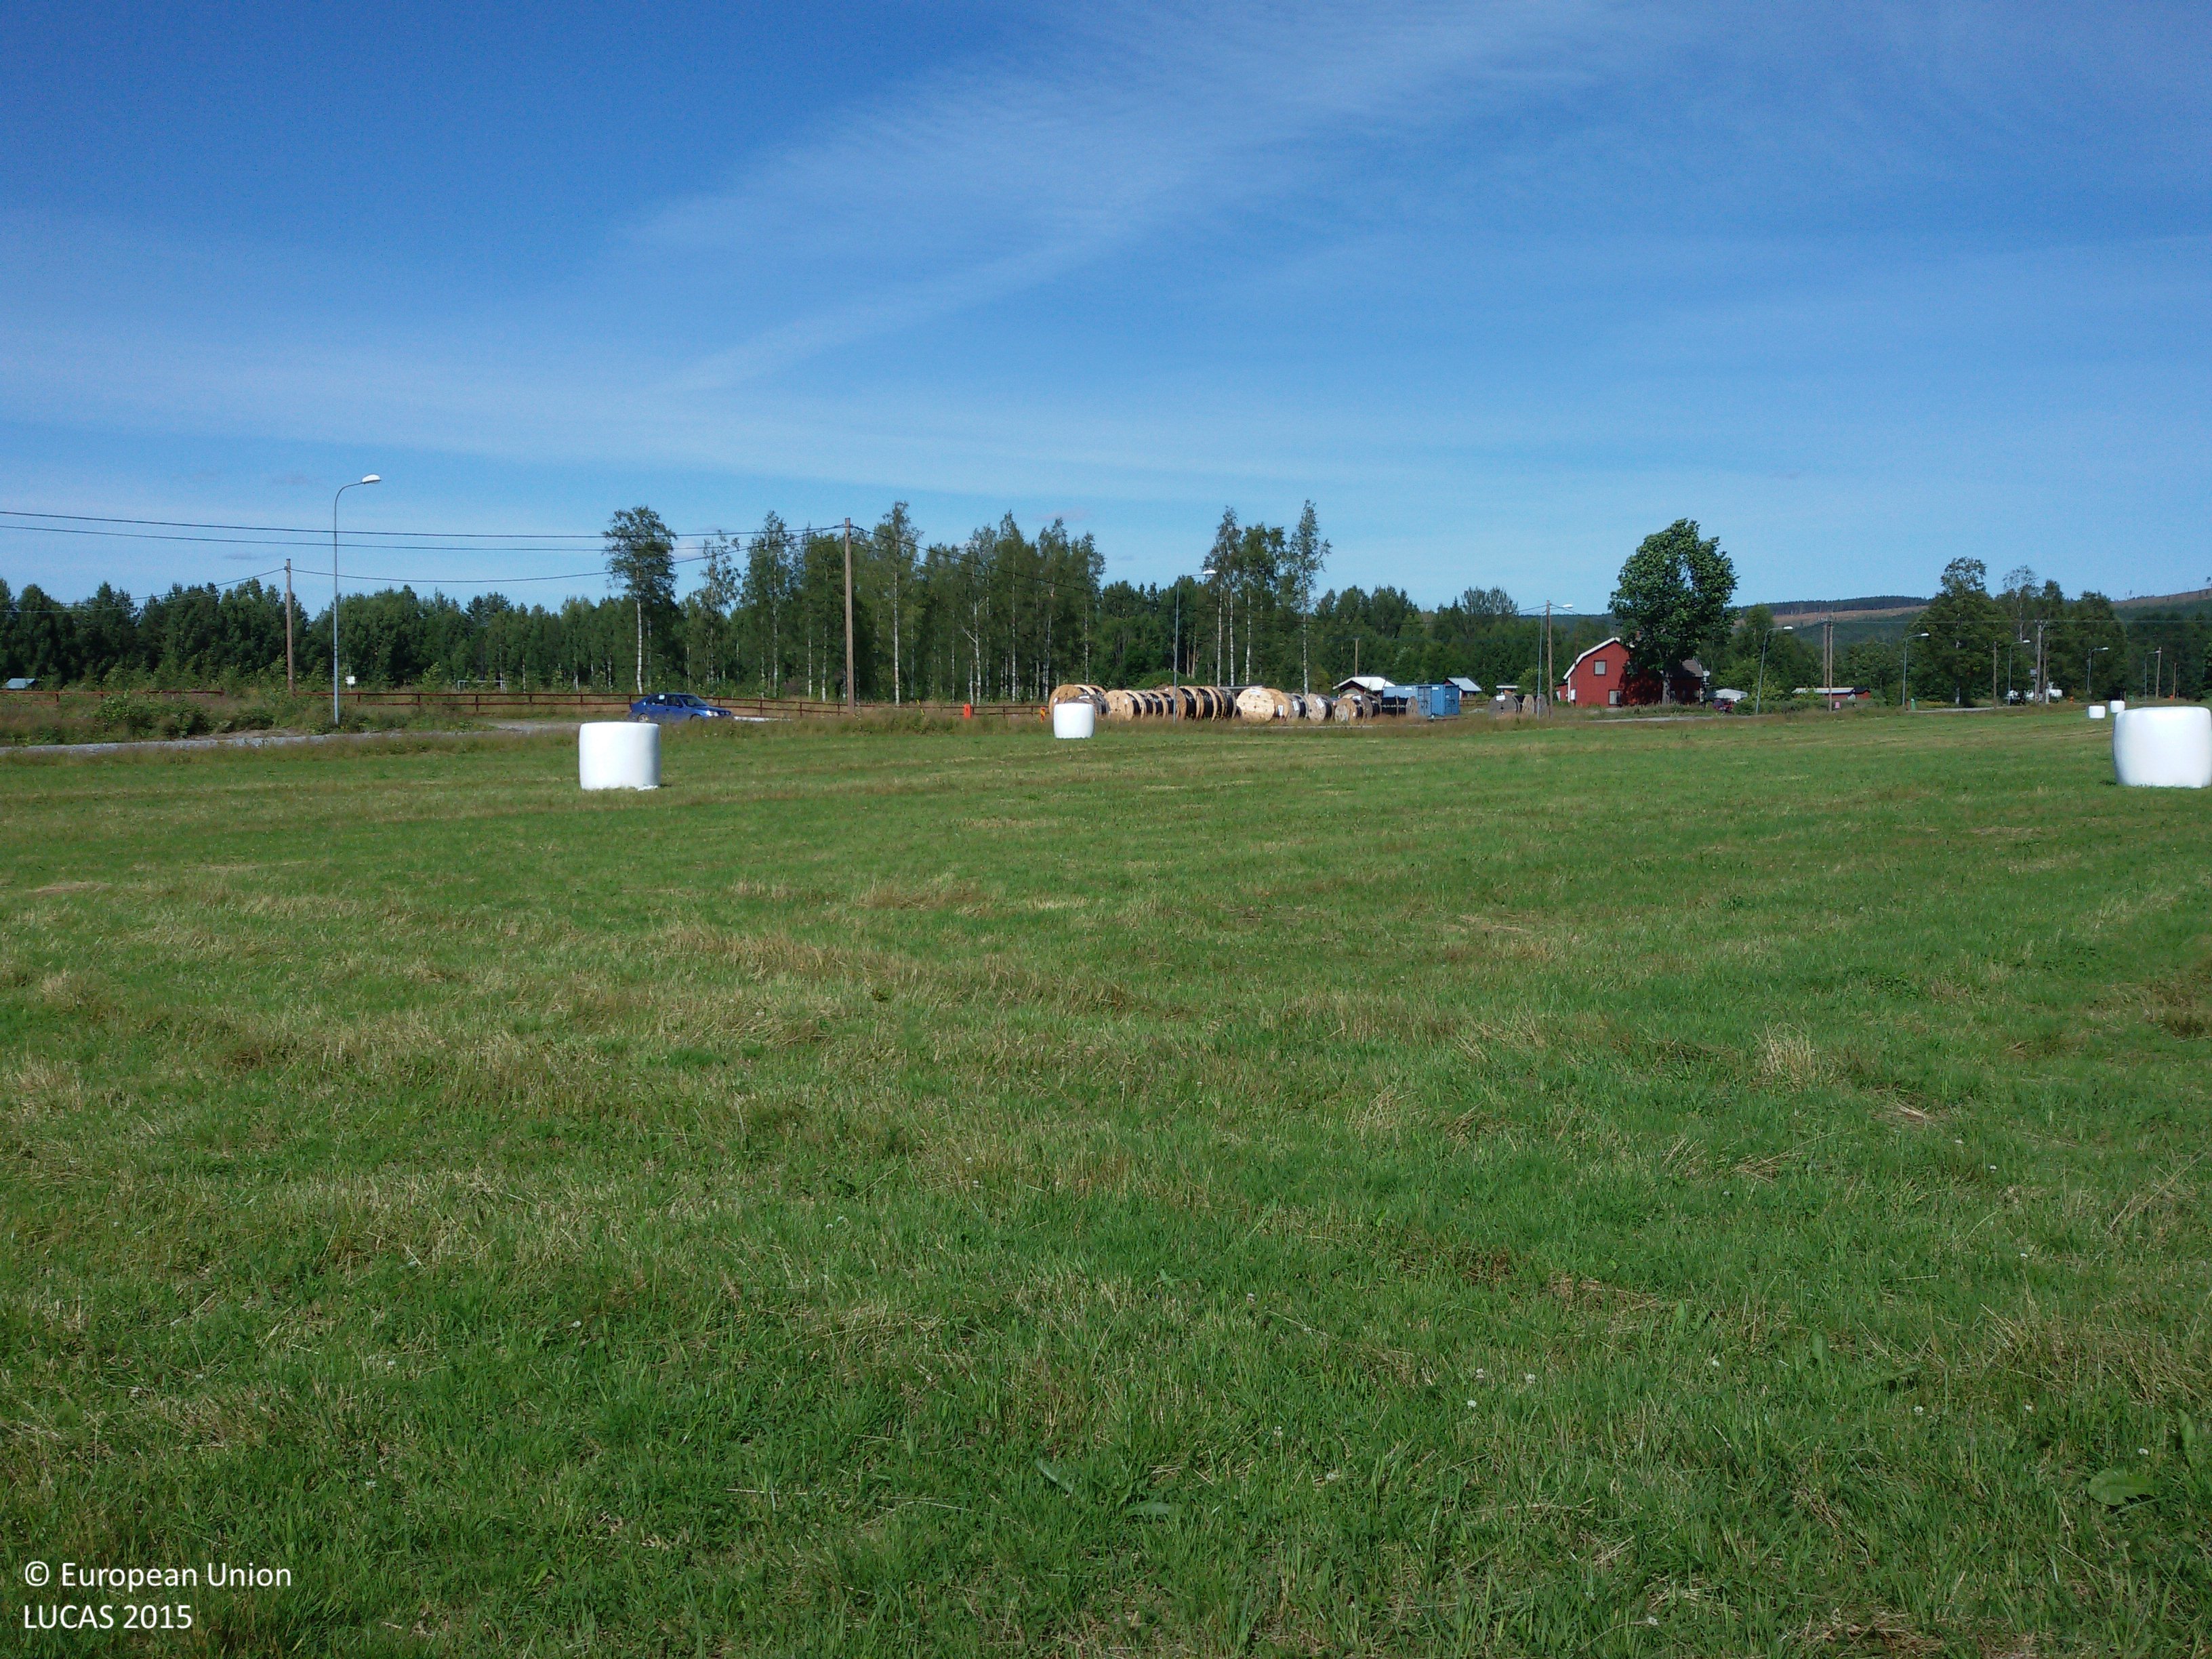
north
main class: Grassland
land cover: Grassland without tree/shrub cover
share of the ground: > 75 %
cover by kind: herbaceous plants 100 %
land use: Agriculture (excluding fallow land and kitchen gardens)
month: August
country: SE
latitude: 60.9557
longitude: 16.4308
